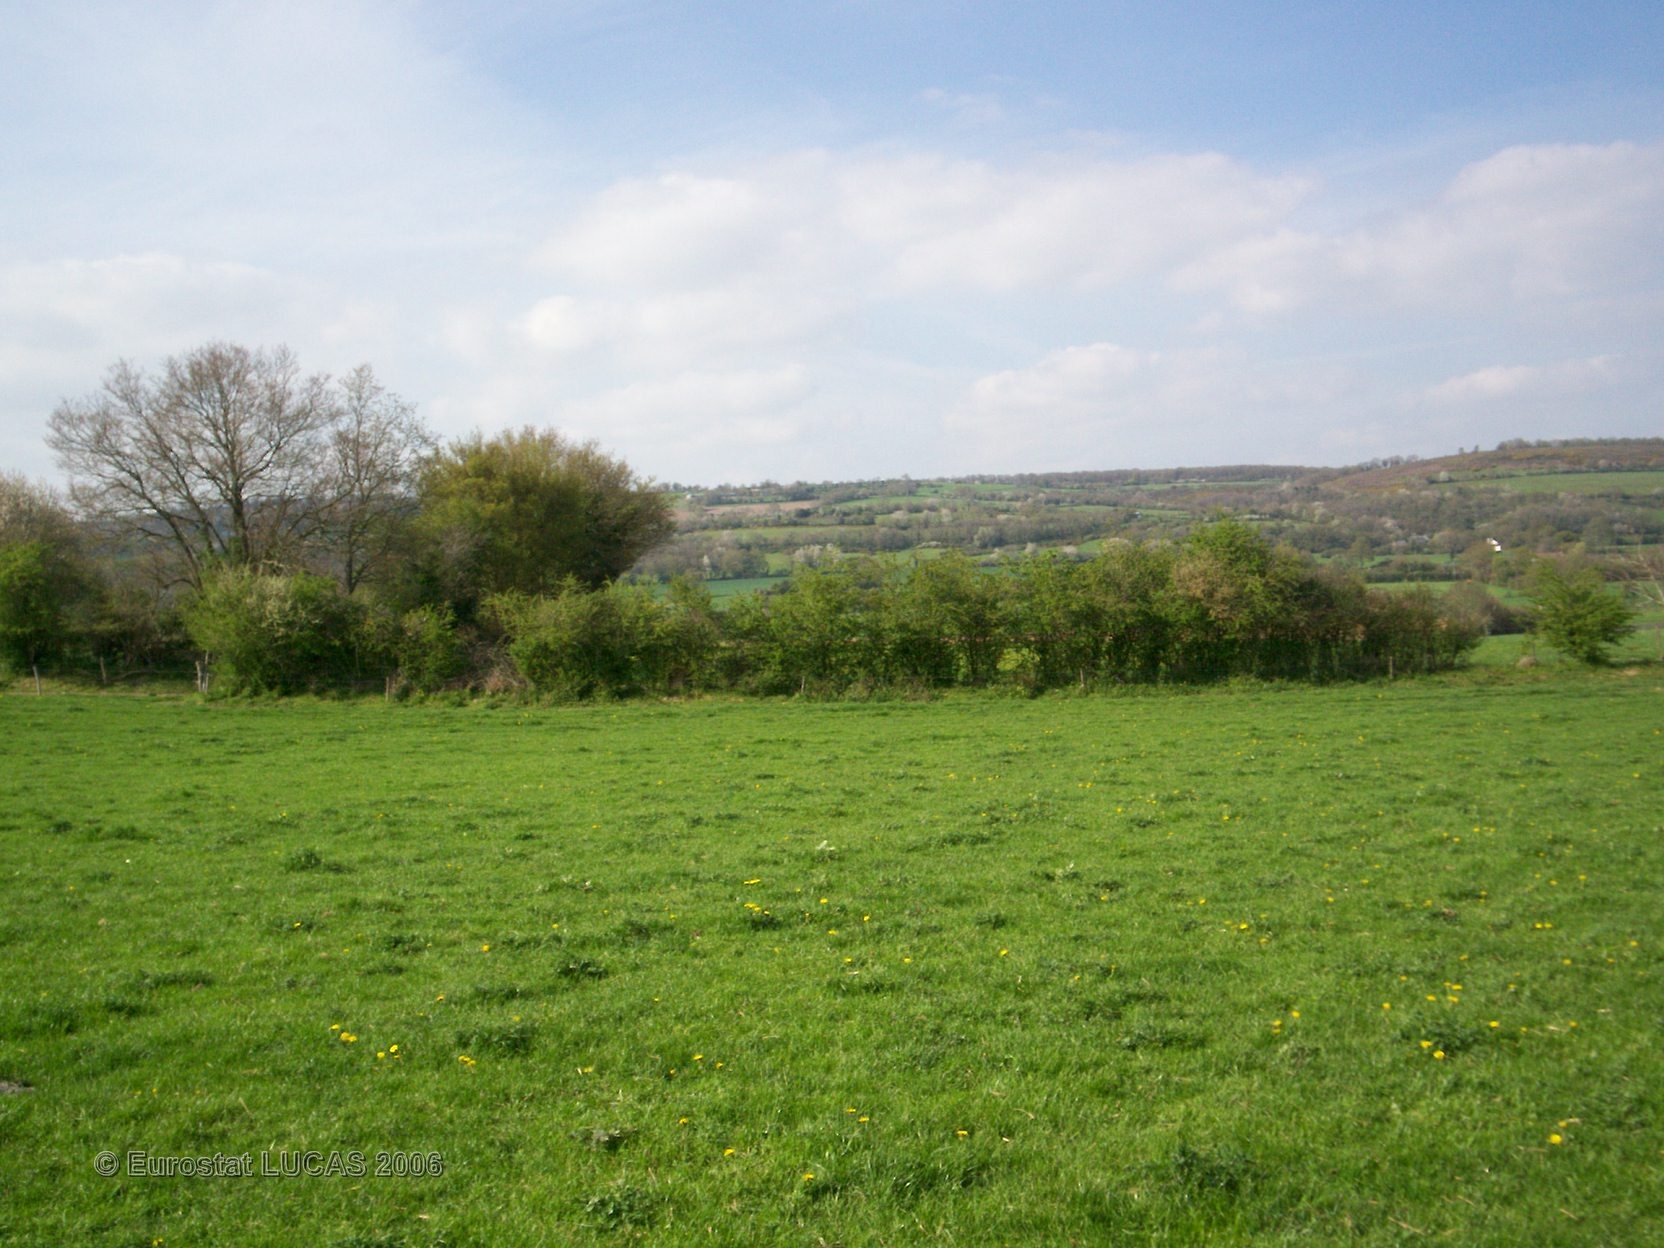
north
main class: Grassland
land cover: Grassland without tree/shrub cover
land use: Agriculture (excluding fallow land and kitchen gardens)
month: April
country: FR
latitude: 48.1452
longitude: -0.2320
